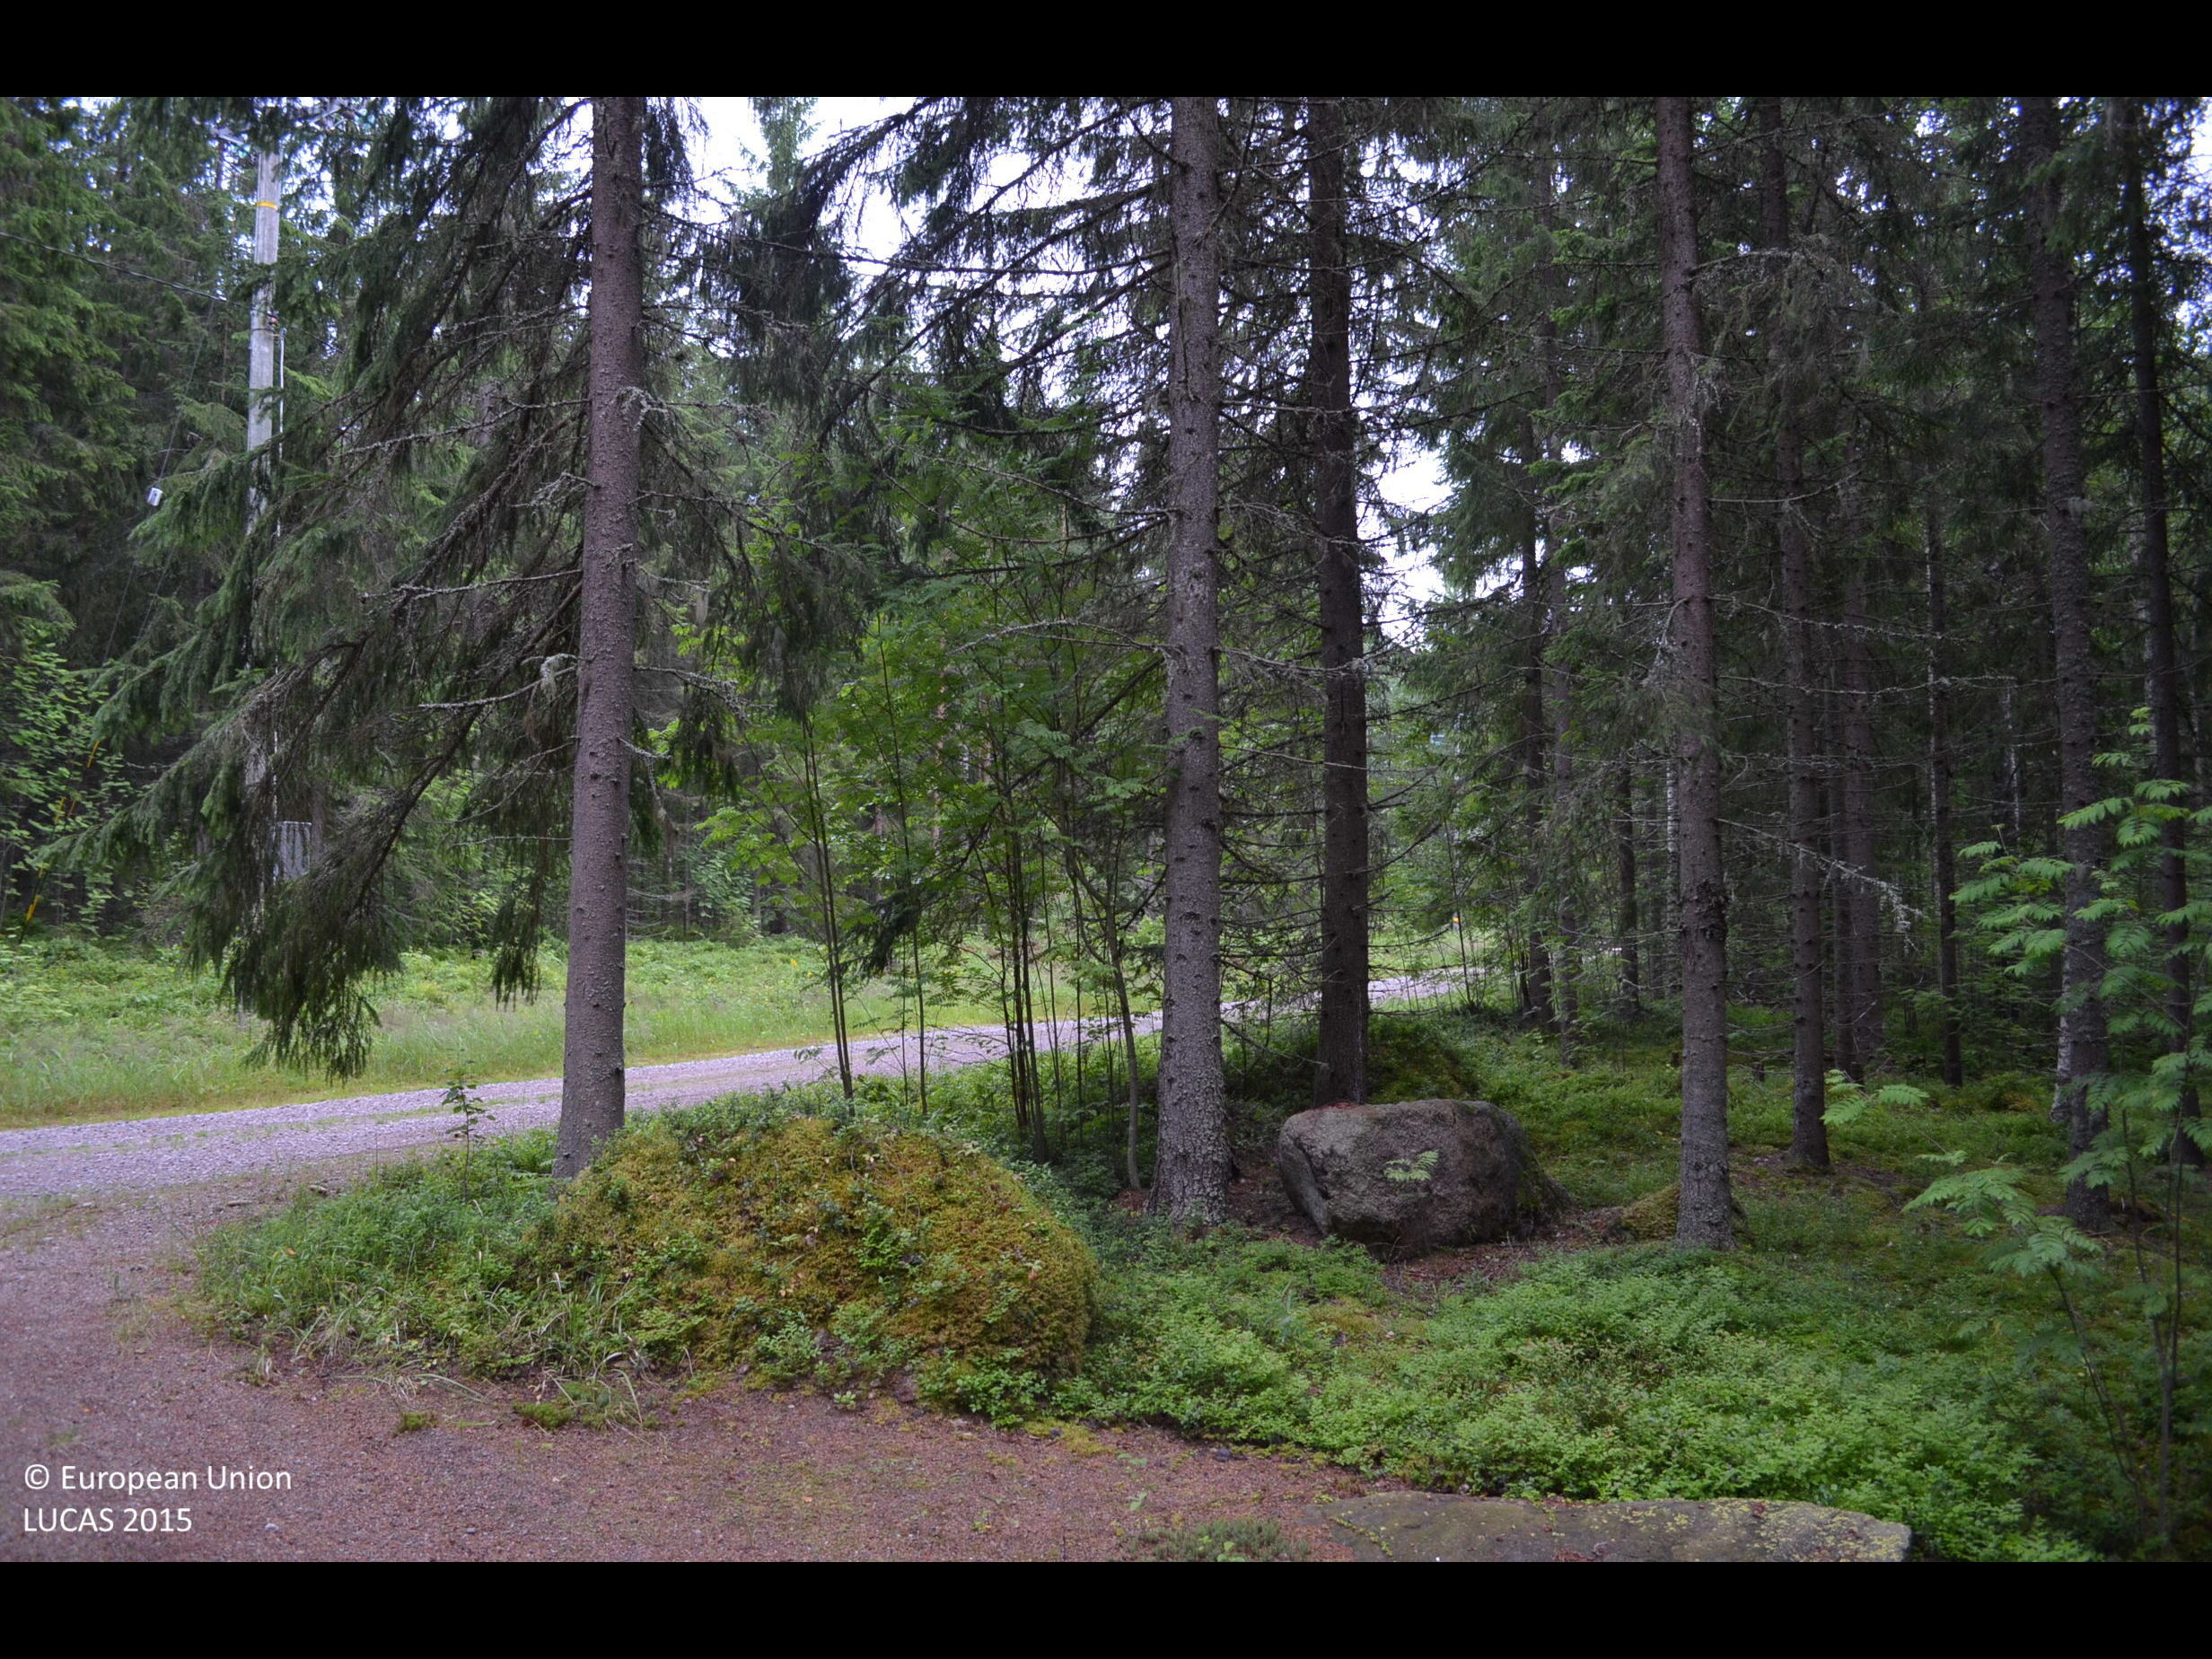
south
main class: Woodland
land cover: Spruce dominated coniferous woodland
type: boreal forest
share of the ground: > 75 %
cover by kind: coniferous forest trees 75 %, shrubs 15 %, broadleaved forest trees 10 %
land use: Forestry
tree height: > 5 m
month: July
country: FI
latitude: 62.0363
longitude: 24.0983
